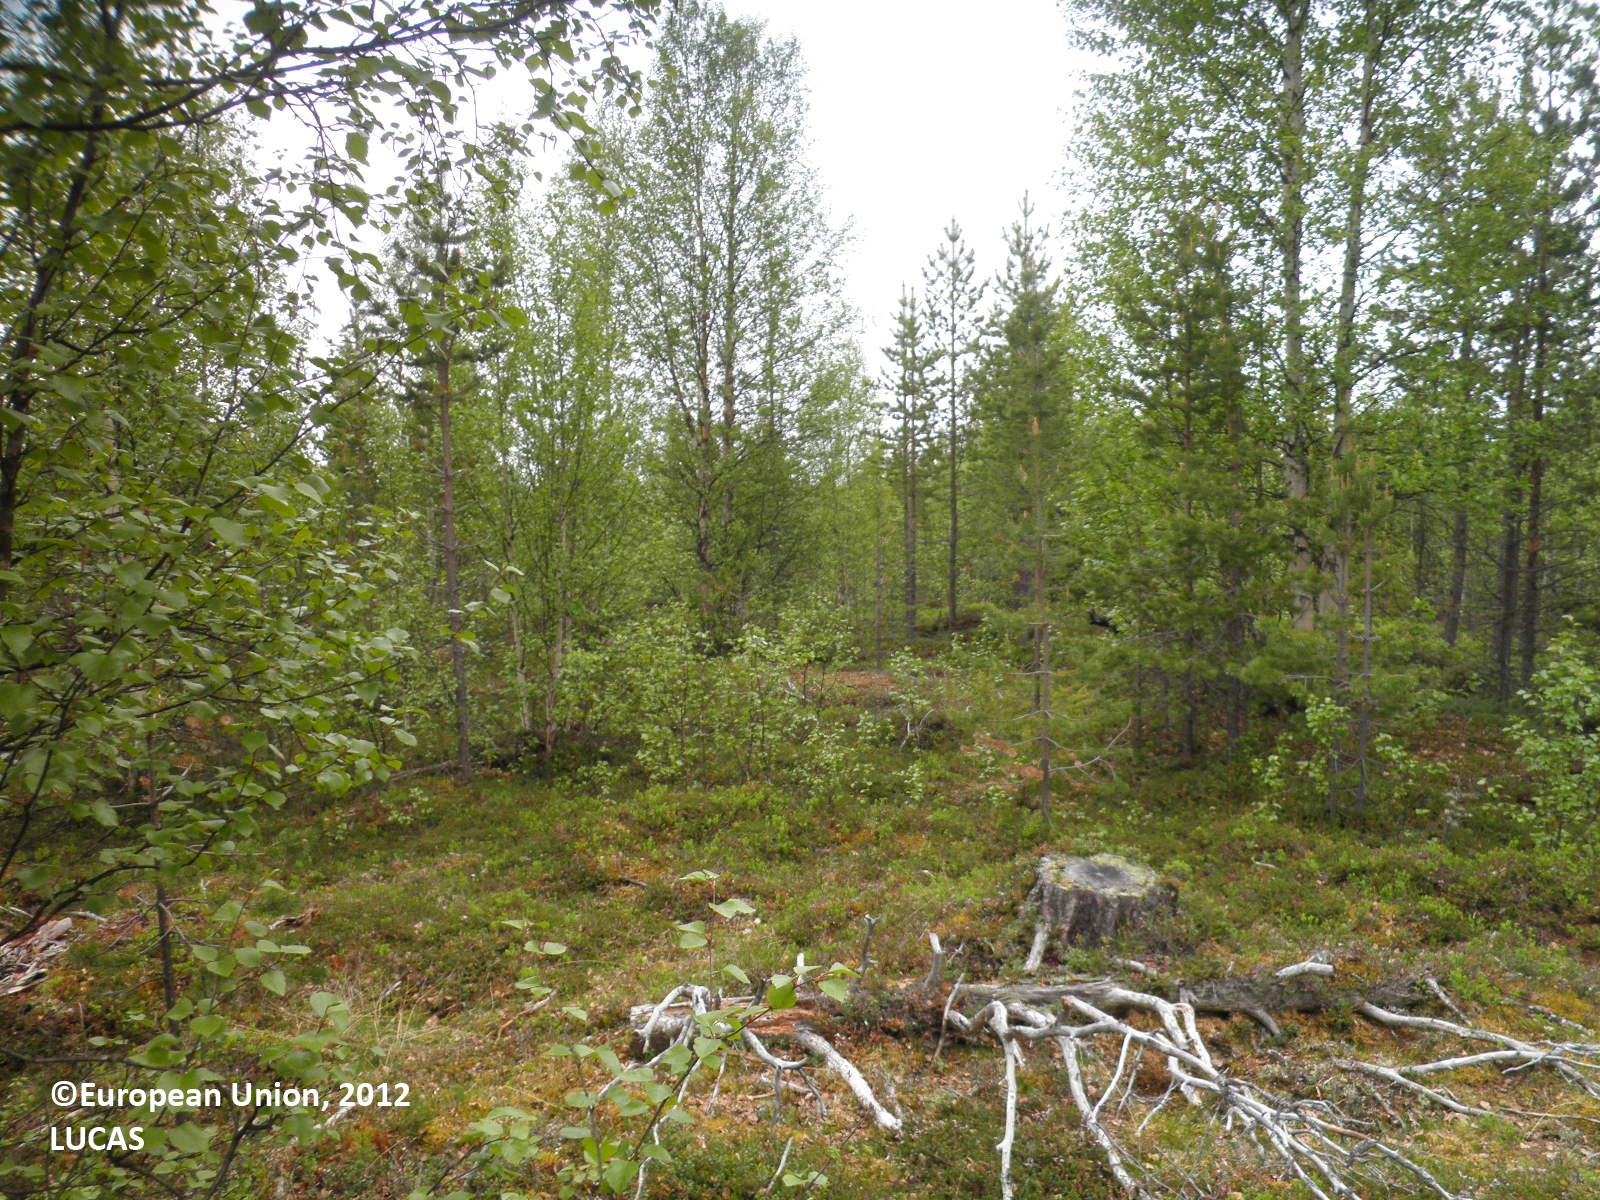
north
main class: Woodland
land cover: Pine dominated mixed woodland
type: boreal forest
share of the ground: 25 - 50 %
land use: Forestry
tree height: < 5 m
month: June
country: FI
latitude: 67.8407
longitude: 25.6557
